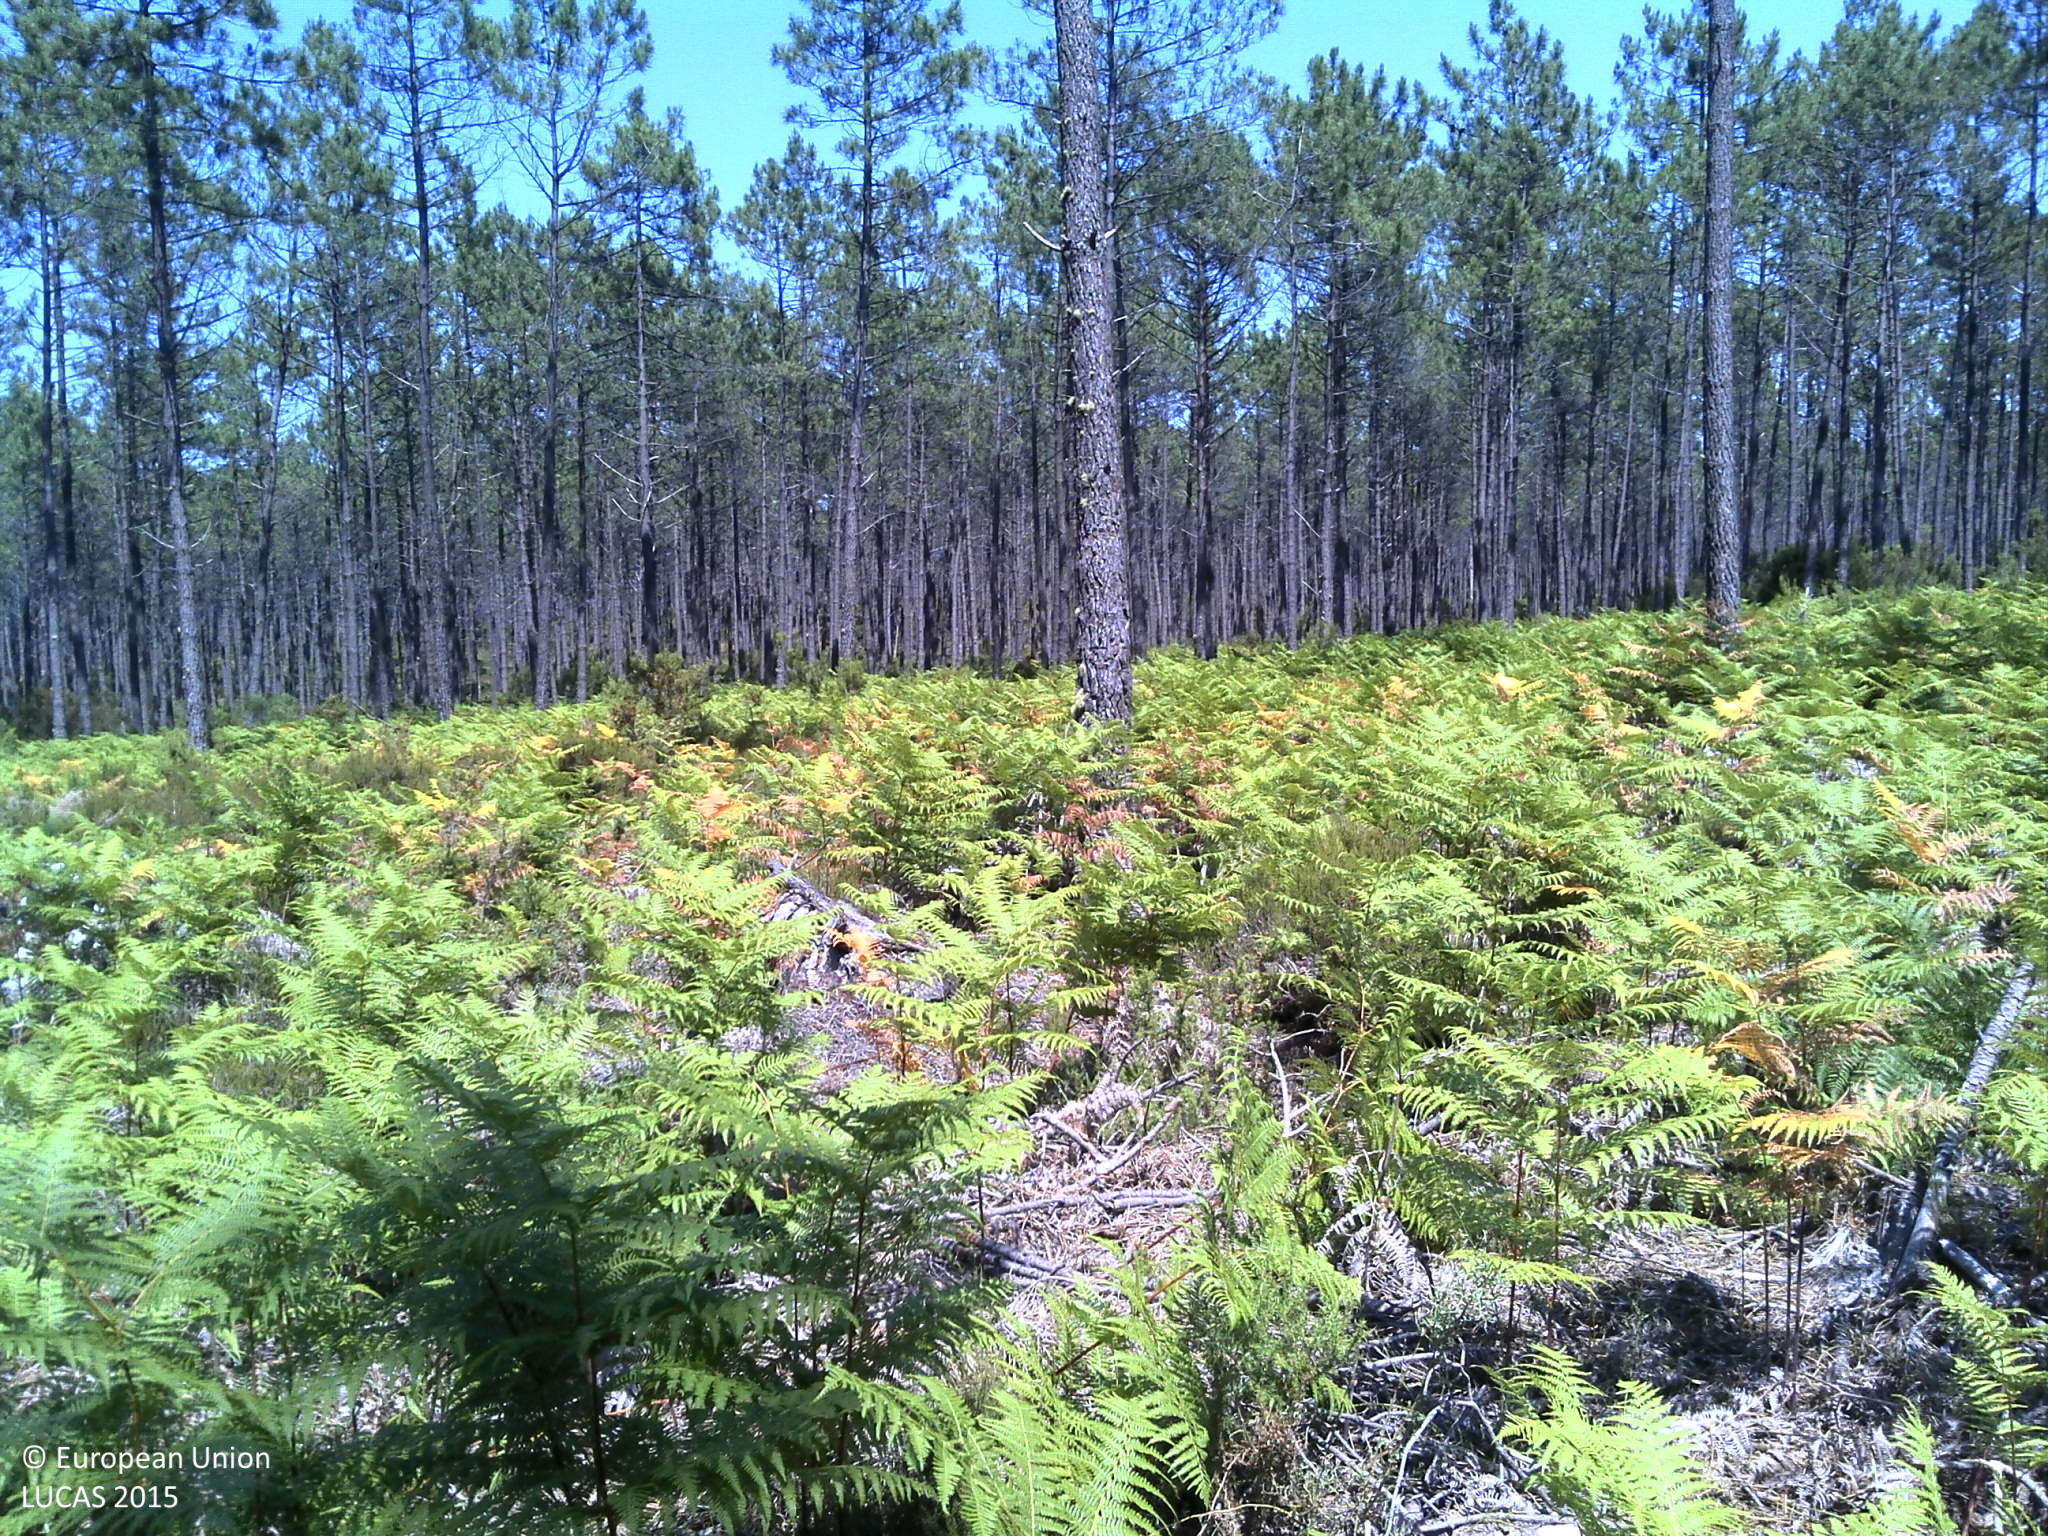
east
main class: Woodland
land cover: Pine dominated coniferous woodland
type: coniferous forest of the mediterranean region
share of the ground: 50 - 75 %
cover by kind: coniferous forest trees 50 %, unconsolidated bare surface 25 %, herbaceous plants 15 %, shrubs 10 %
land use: Forestry
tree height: > 5 m
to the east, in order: Pine dominated coniferous woodland; Tracks; Pine dominated coniferous woodland
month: June
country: PT
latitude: 39.8343
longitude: -8.9154
